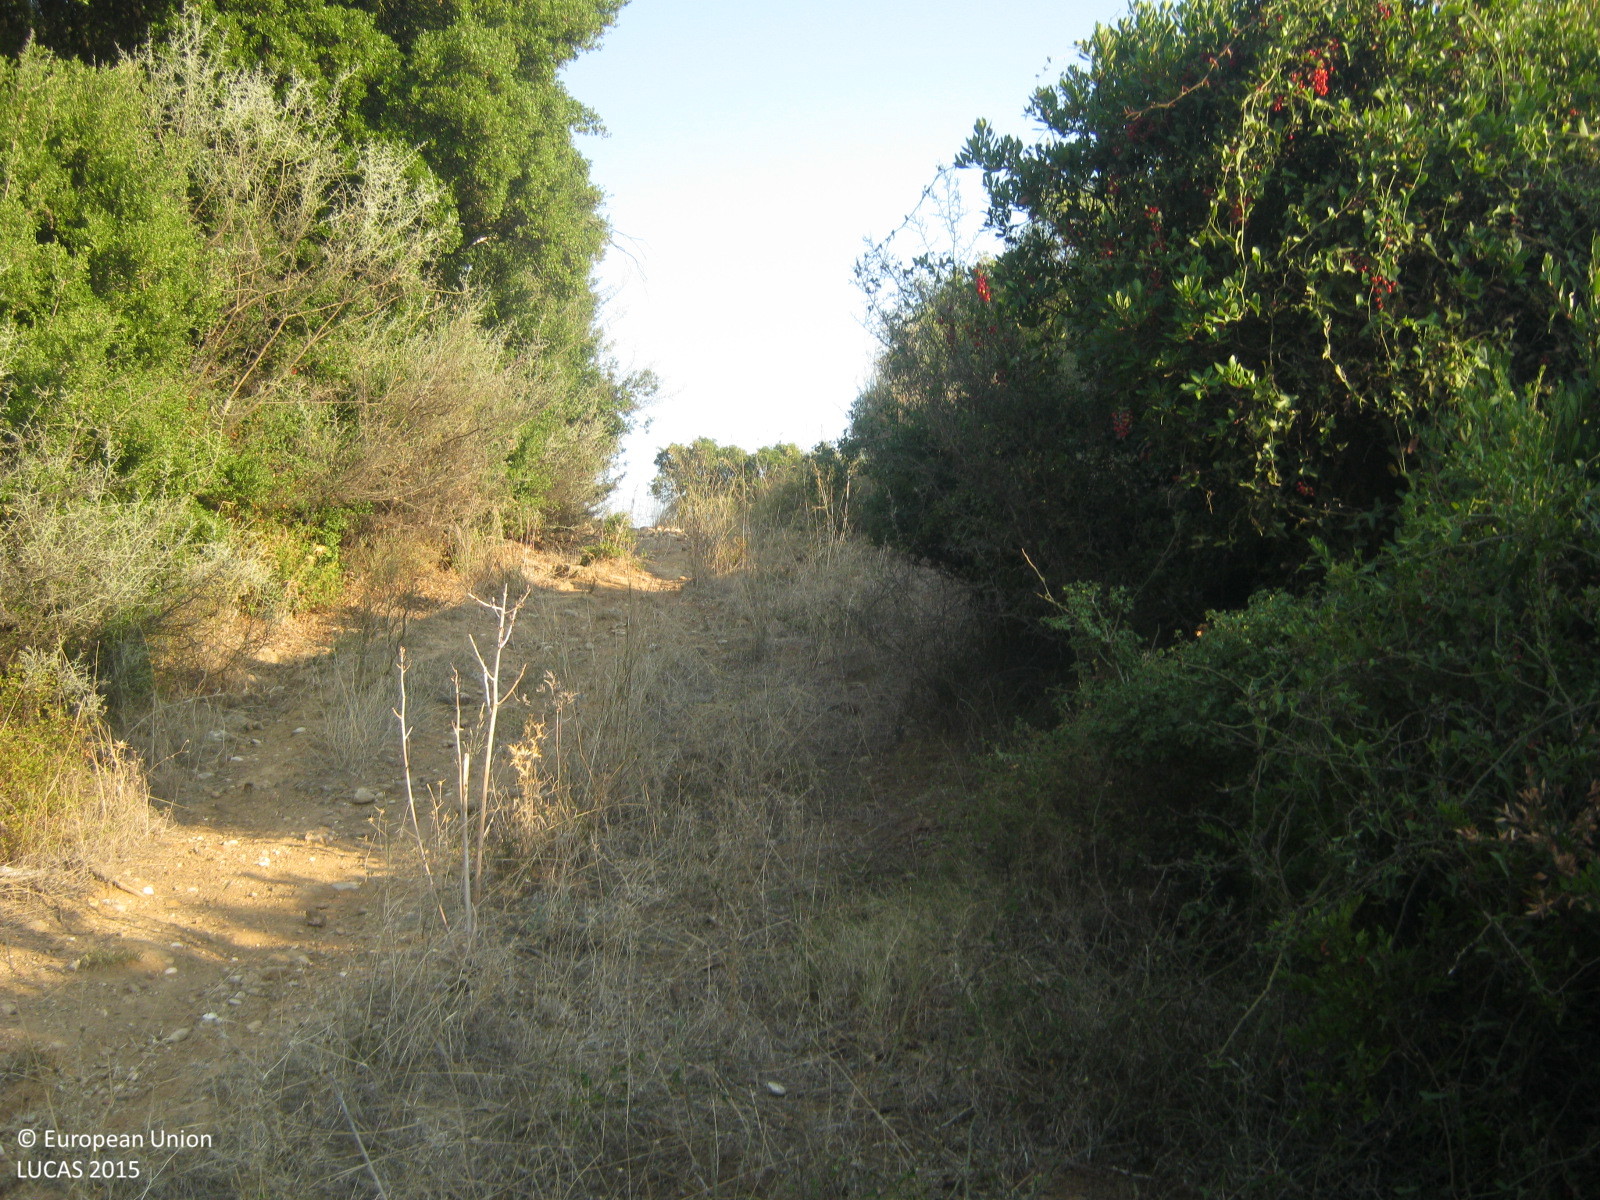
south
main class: Shrubland
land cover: Shrubland with sparse tree cover
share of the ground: > 75 %
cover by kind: shrubs 85 %, herbaceous plants 10 %, broadleaved forest trees 5 %
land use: Semi-natural and natural areas not in use
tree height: < 5 m
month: September
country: GR
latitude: 37.8572
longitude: 21.6119
